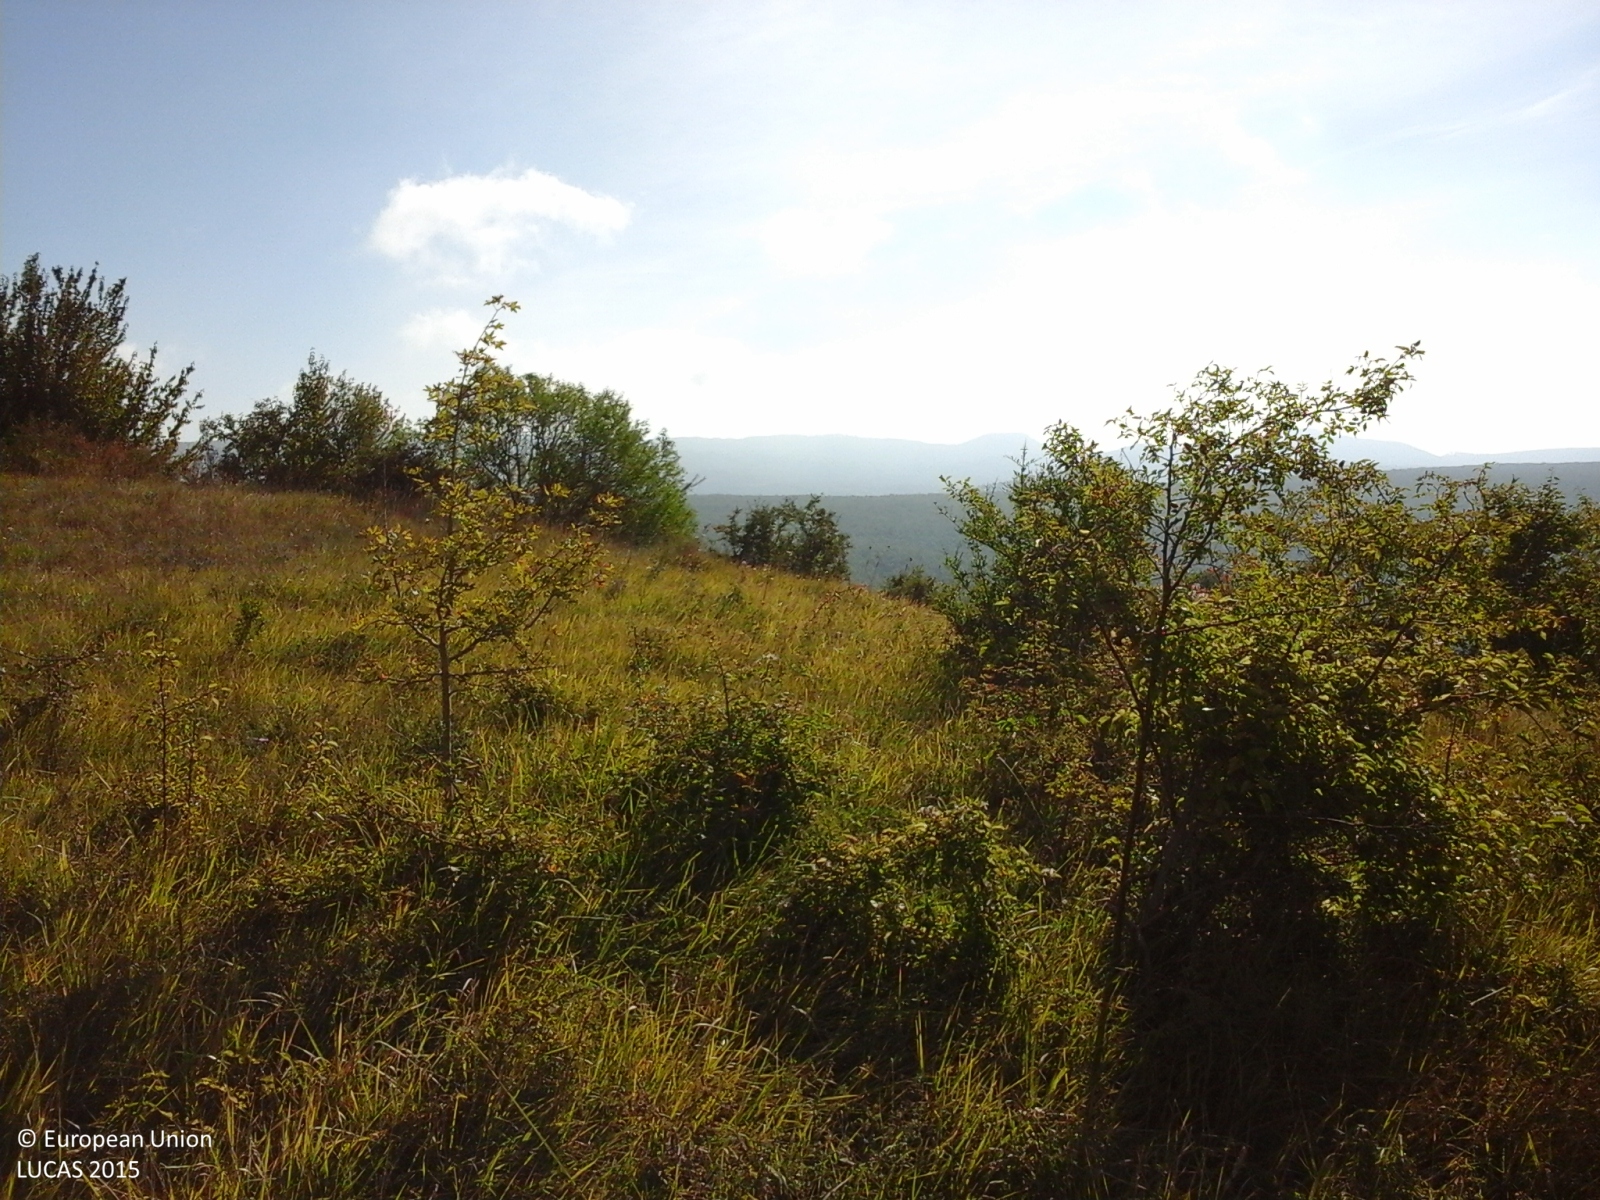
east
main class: Grassland
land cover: Grassland with sparse tree/shrub cover
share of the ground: > 75 %
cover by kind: herbaceous plants 90 %, broadleaved forest trees 5 %, shrubs 5 %
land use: Agriculture (excluding fallow land and kitchen gardens)
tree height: > 5 m
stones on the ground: < 10 %
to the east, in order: Grassland with sparse tree/shrub cover; Dry stone walls; Grassland without tree/shrub cover; Grassland with sparse tree/shrub cover; Broadleaved woodland; Grassland with sparse tree/shrub cover; Electric lines; Grassland with sparse tree/shrub cover
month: August
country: IT
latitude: 41.7305
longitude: 14.3011
